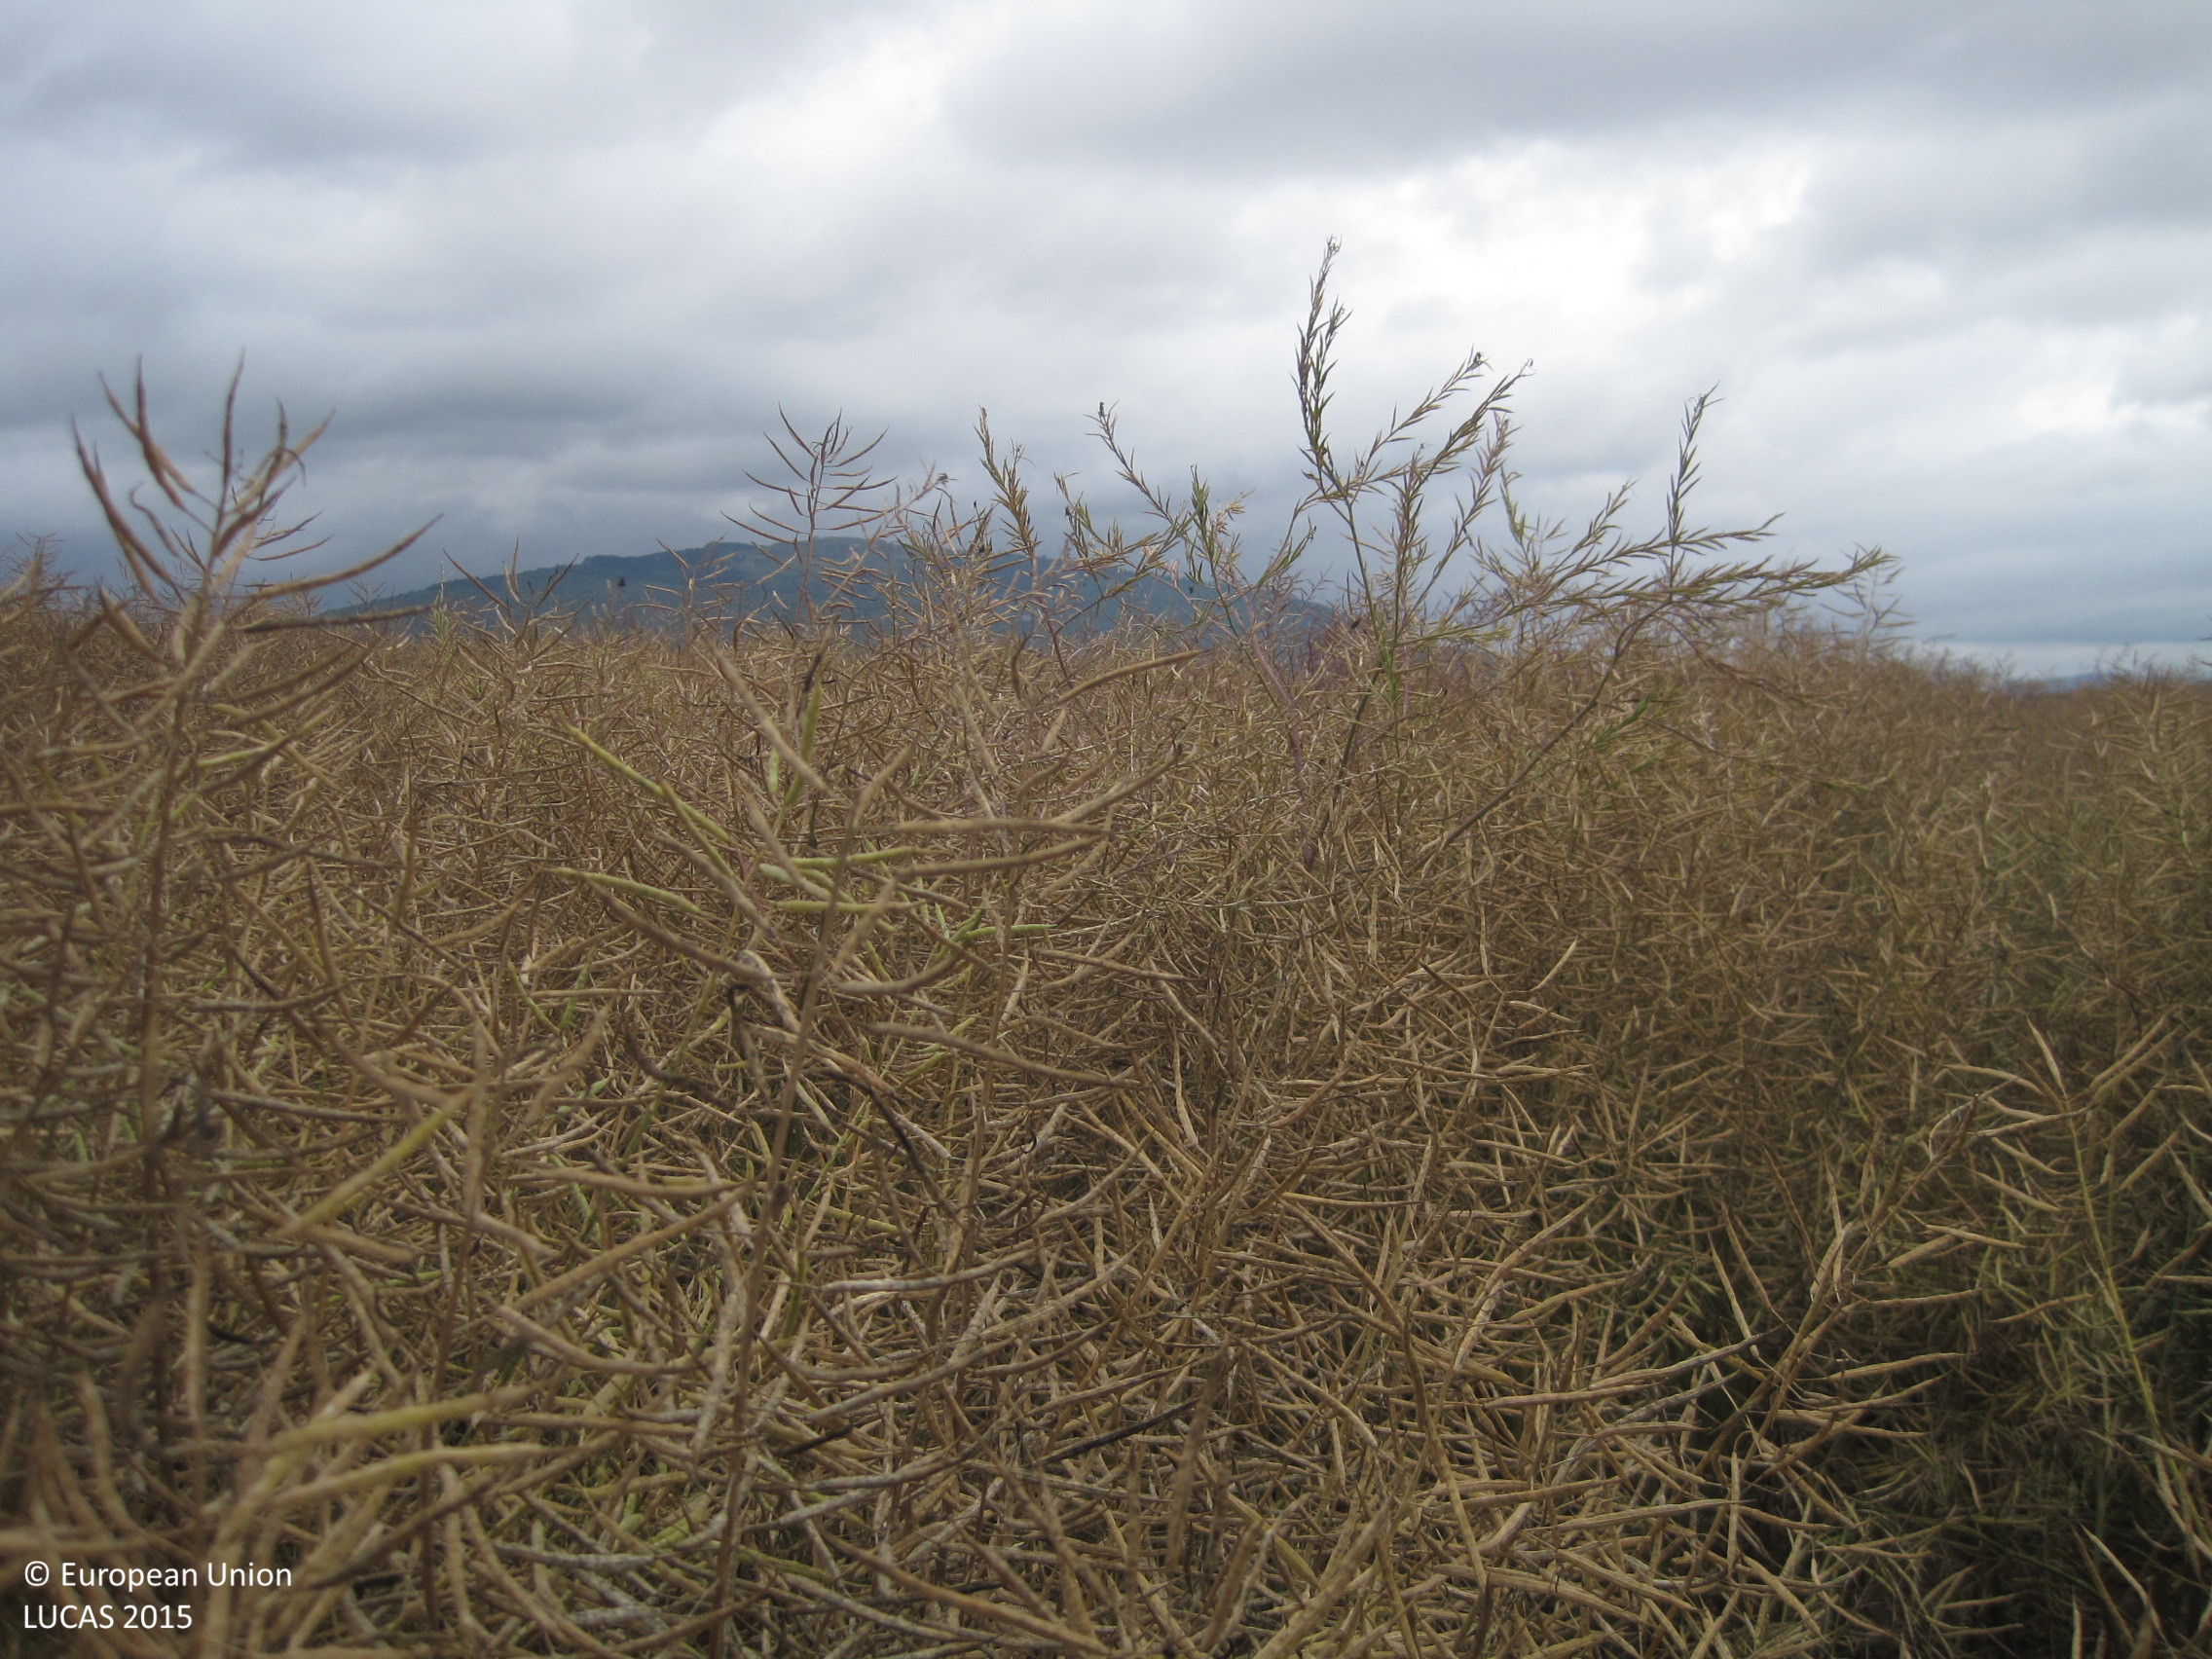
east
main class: Cropland
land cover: Rape and turnip rape
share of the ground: > 75 %
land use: Agriculture (excluding fallow land and kitchen gardens)
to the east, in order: Rape and turnip rape; Common wheat
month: June
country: ES
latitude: 42.8454
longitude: -1.7257
